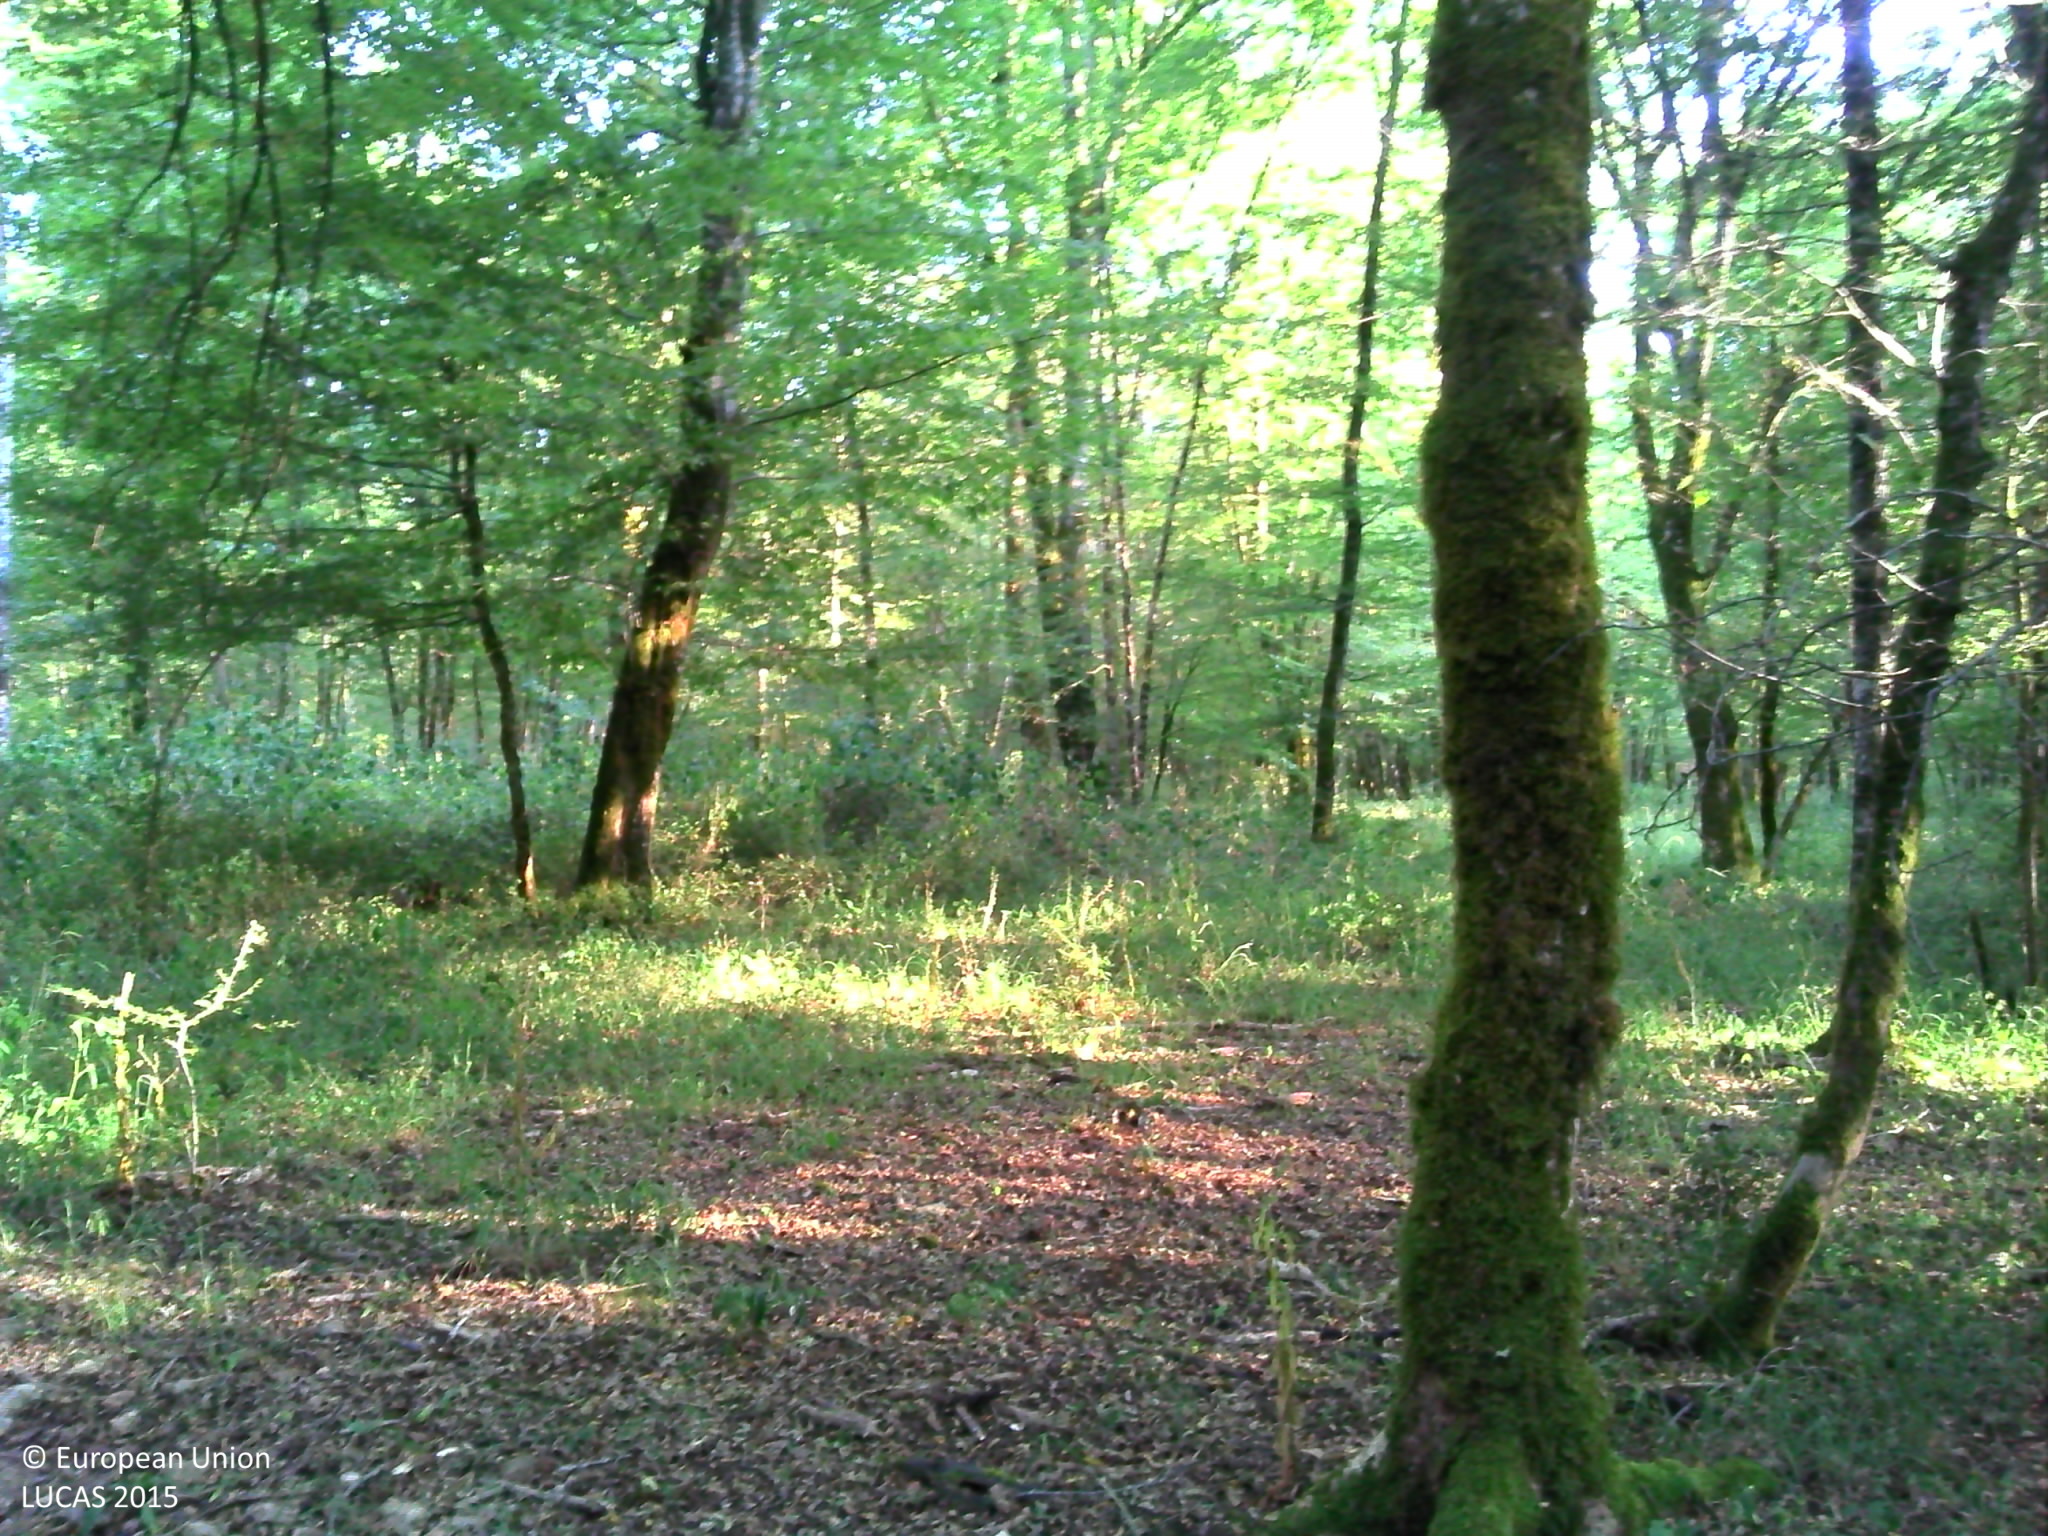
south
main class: Woodland
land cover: Broadleaved woodland
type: mesophytic deciduous forest
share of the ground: > 75 %
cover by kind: broadleaved forest trees 75 %, shrubs 10 %, lichens and mosses 10 %, herbaceous plants 5 %
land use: Forestry
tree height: > 5 m
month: July
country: FR
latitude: 48.0199
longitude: 4.9980
